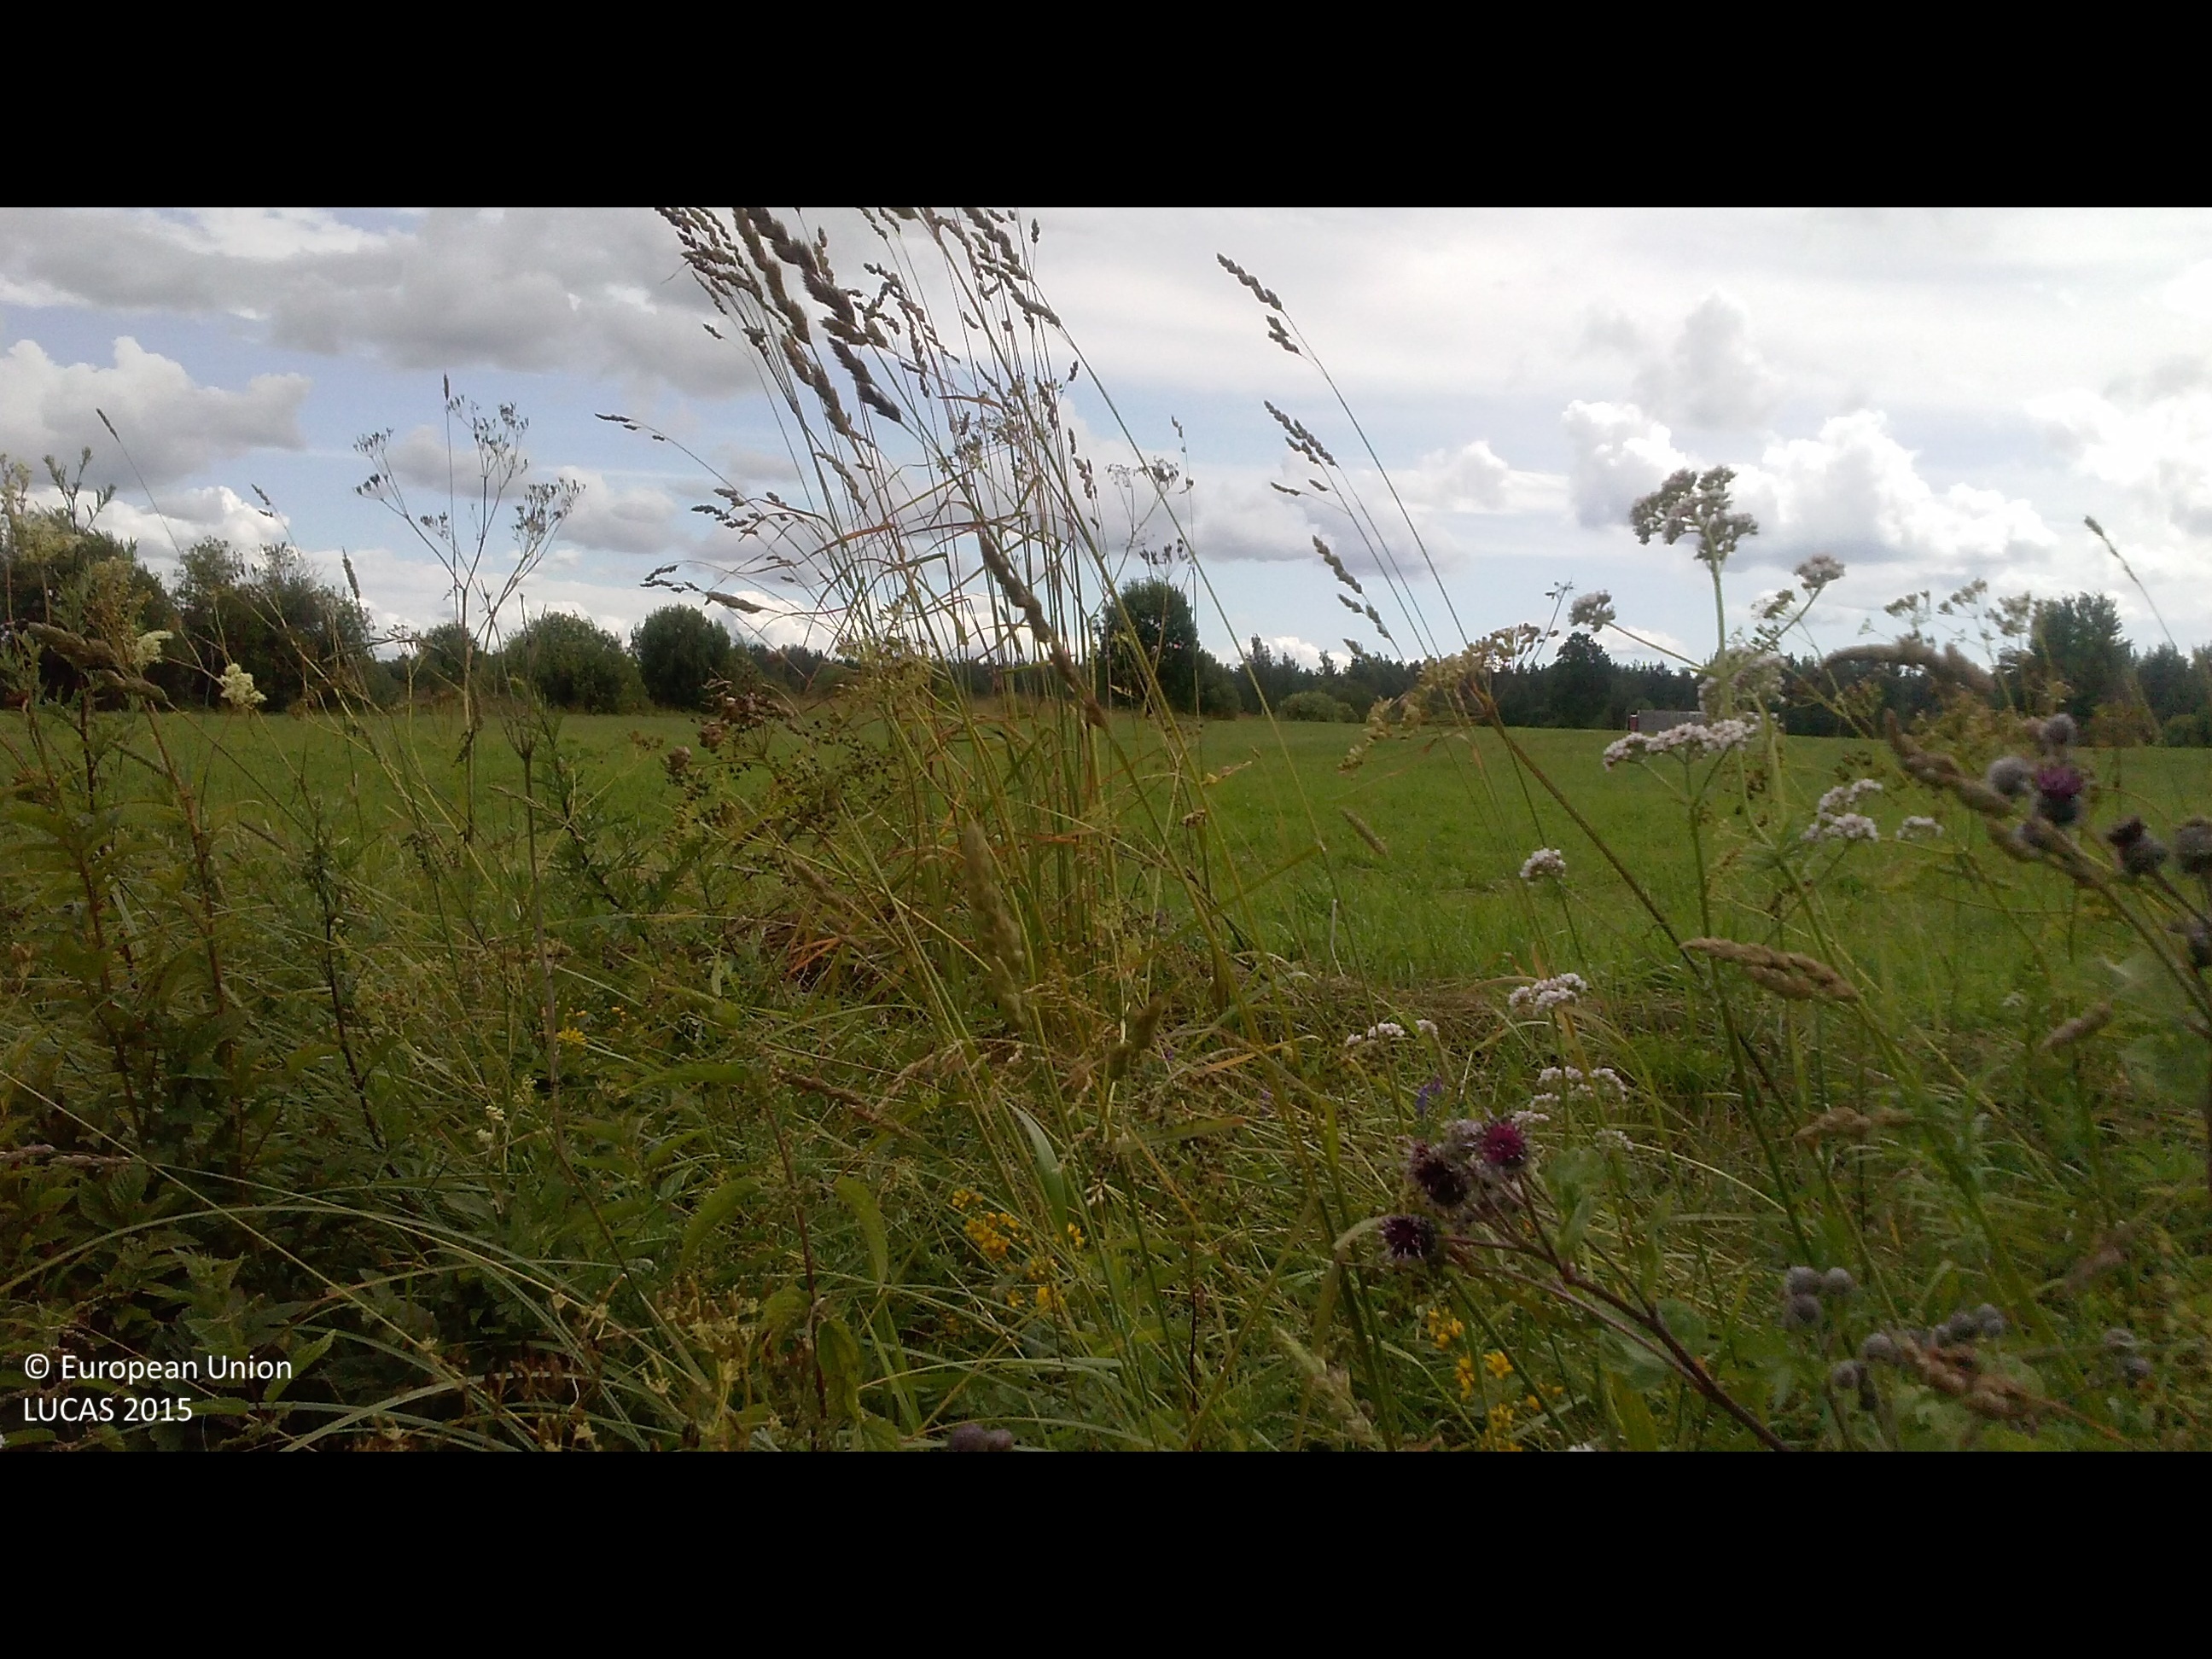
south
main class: Grassland
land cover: Spontaneously vegetated surfaces
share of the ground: > 75 %
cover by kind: herbaceous plants 100 %
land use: Semi-natural and natural areas not in use
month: July
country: LV
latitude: 56.4434
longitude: 26.9842
